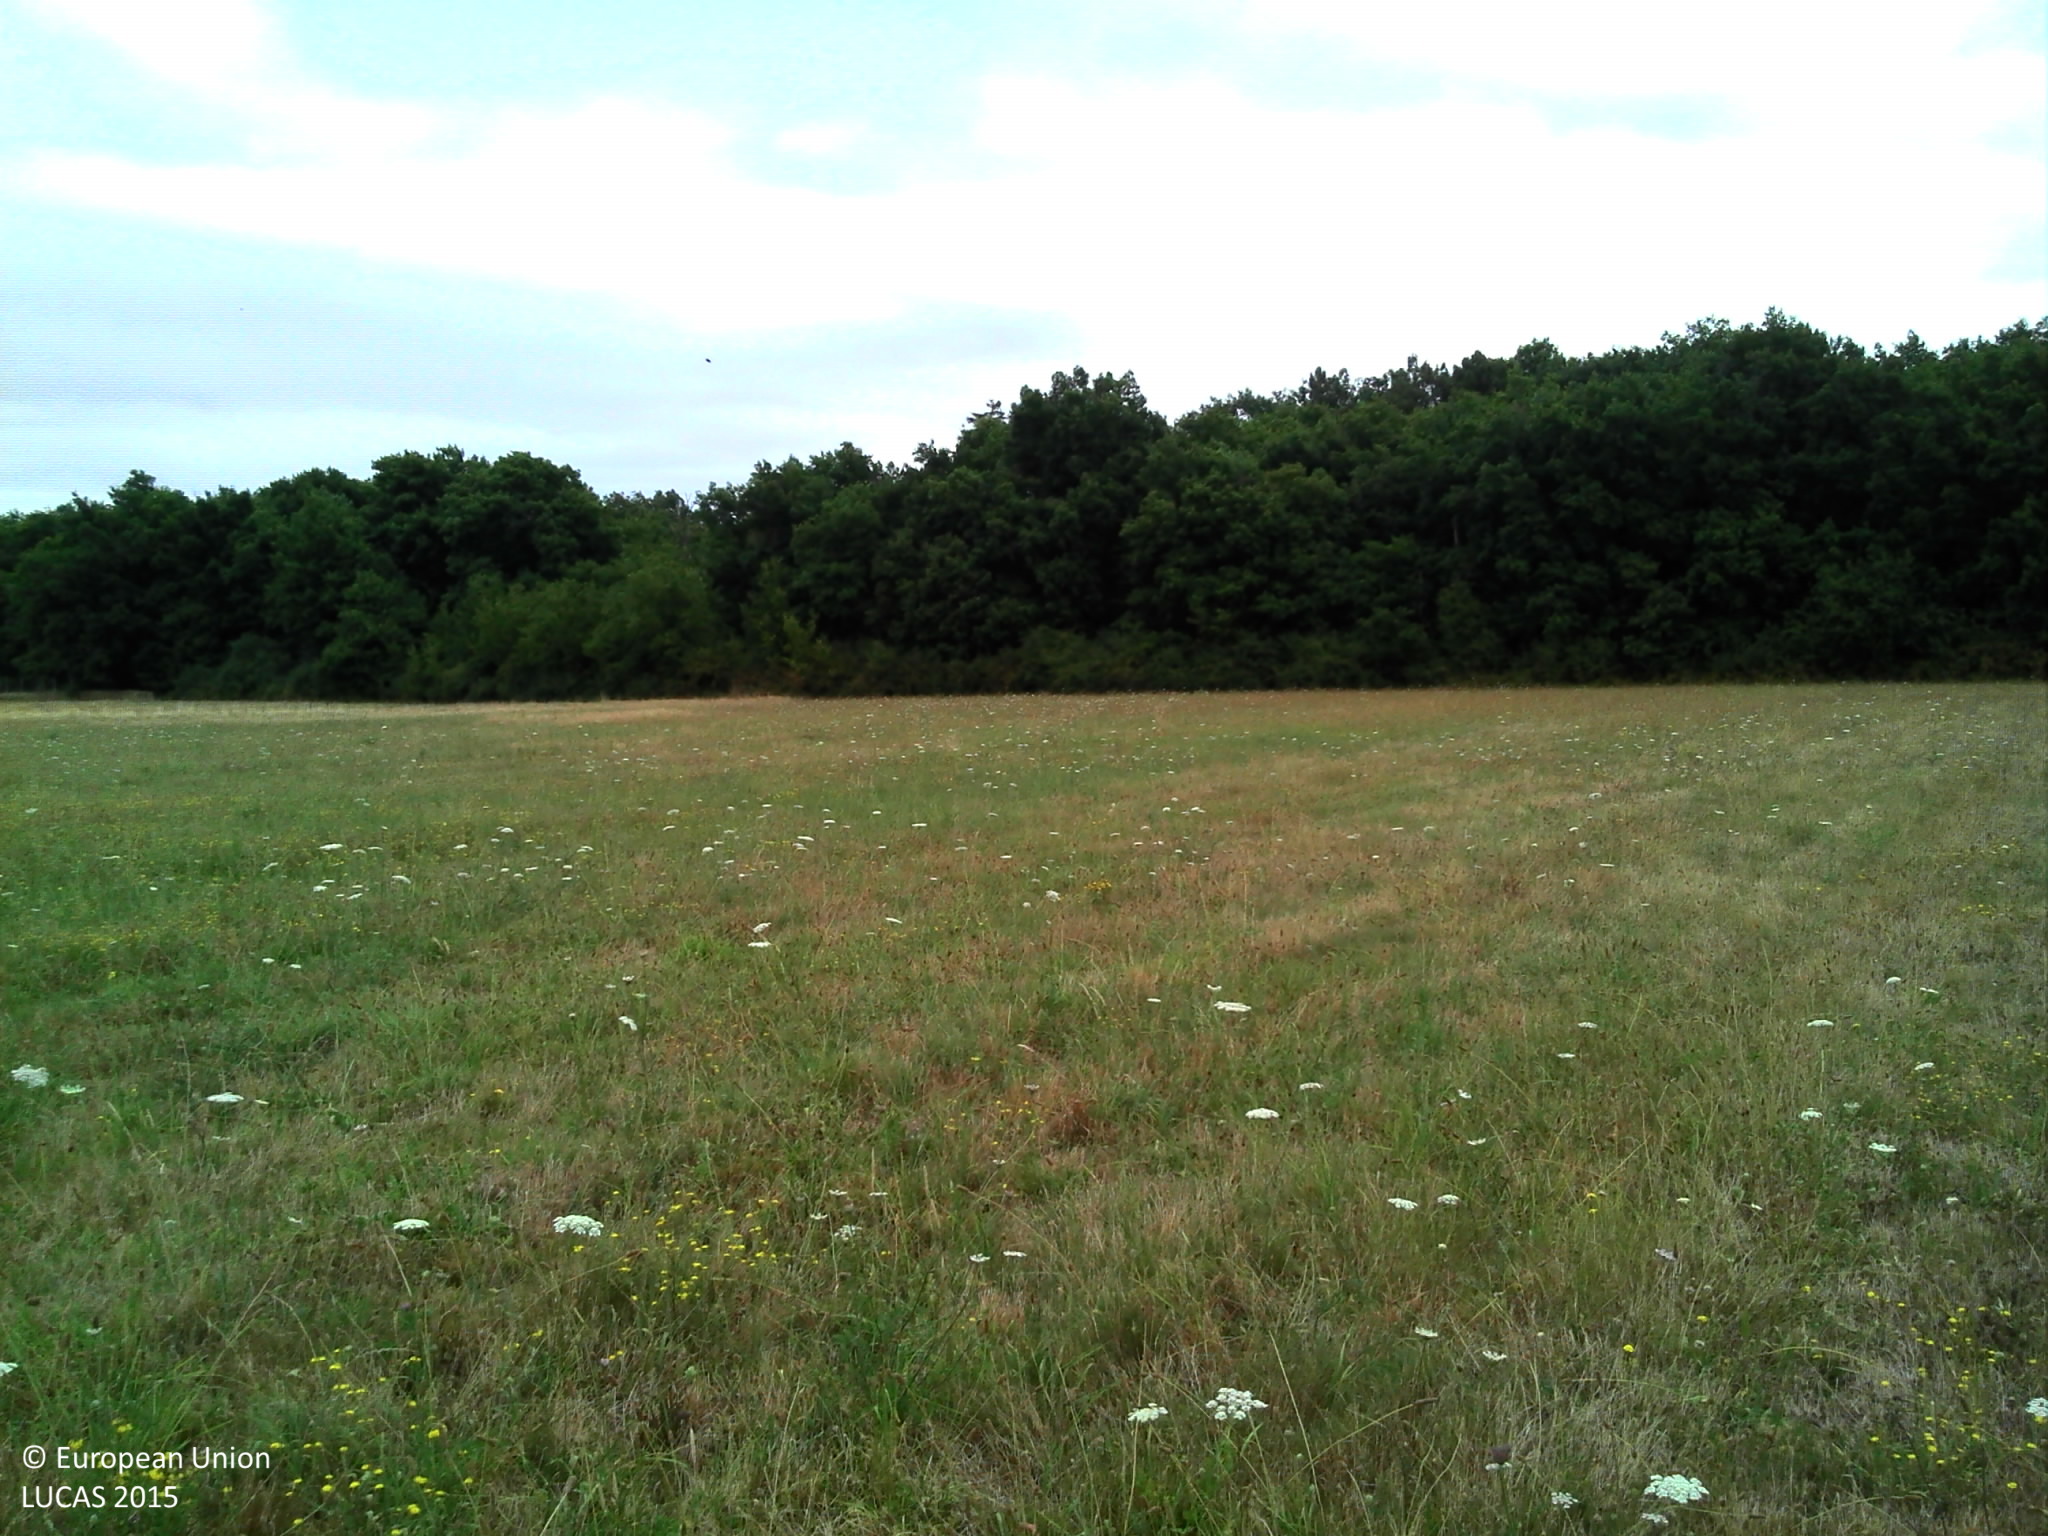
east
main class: Grassland
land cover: Grassland without tree/shrub cover
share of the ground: > 75 %
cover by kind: herbaceous plants 100 %
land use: Agriculture (excluding fallow land and kitchen gardens)
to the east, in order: Grassland without tree/shrub cover; Broadleaved woodland; Fences; Tracks; Broadleaved woodland; Tracks; Broadleaved woodland
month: July
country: FR
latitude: 46.2631
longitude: 0.6042
